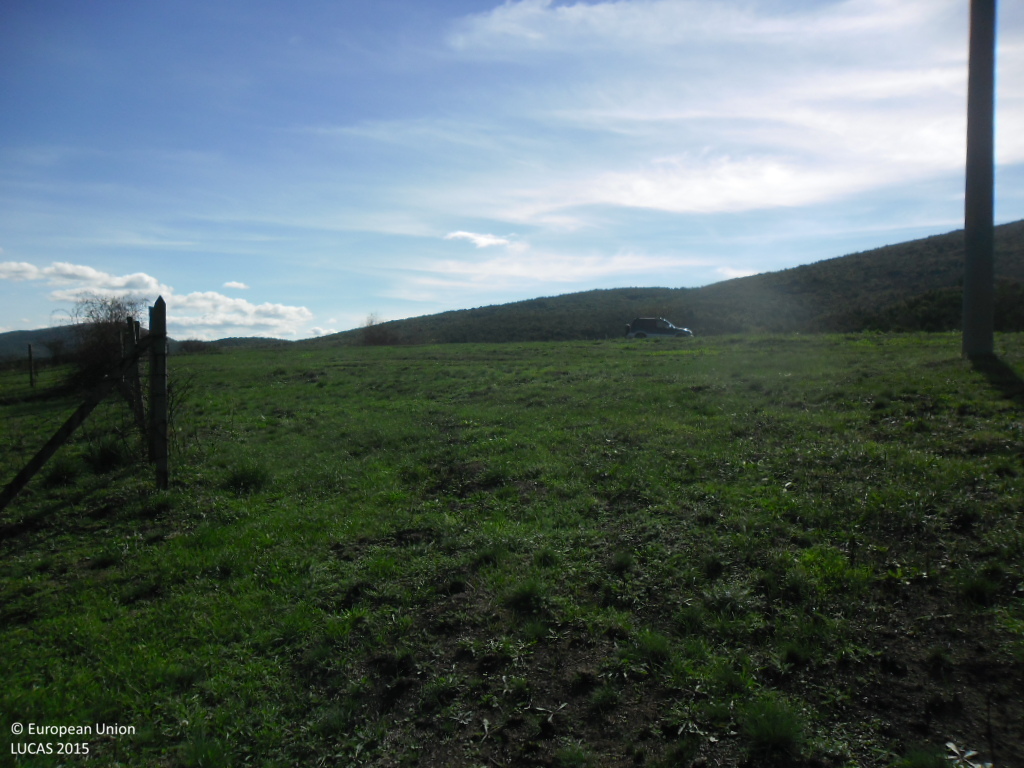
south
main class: Grassland
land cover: Grassland without tree/shrub cover
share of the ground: > 75 %
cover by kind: herbaceous plants 100 %
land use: Agriculture (excluding fallow land and kitchen gardens)
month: October
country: BG
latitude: 42.0760
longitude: 22.7972
